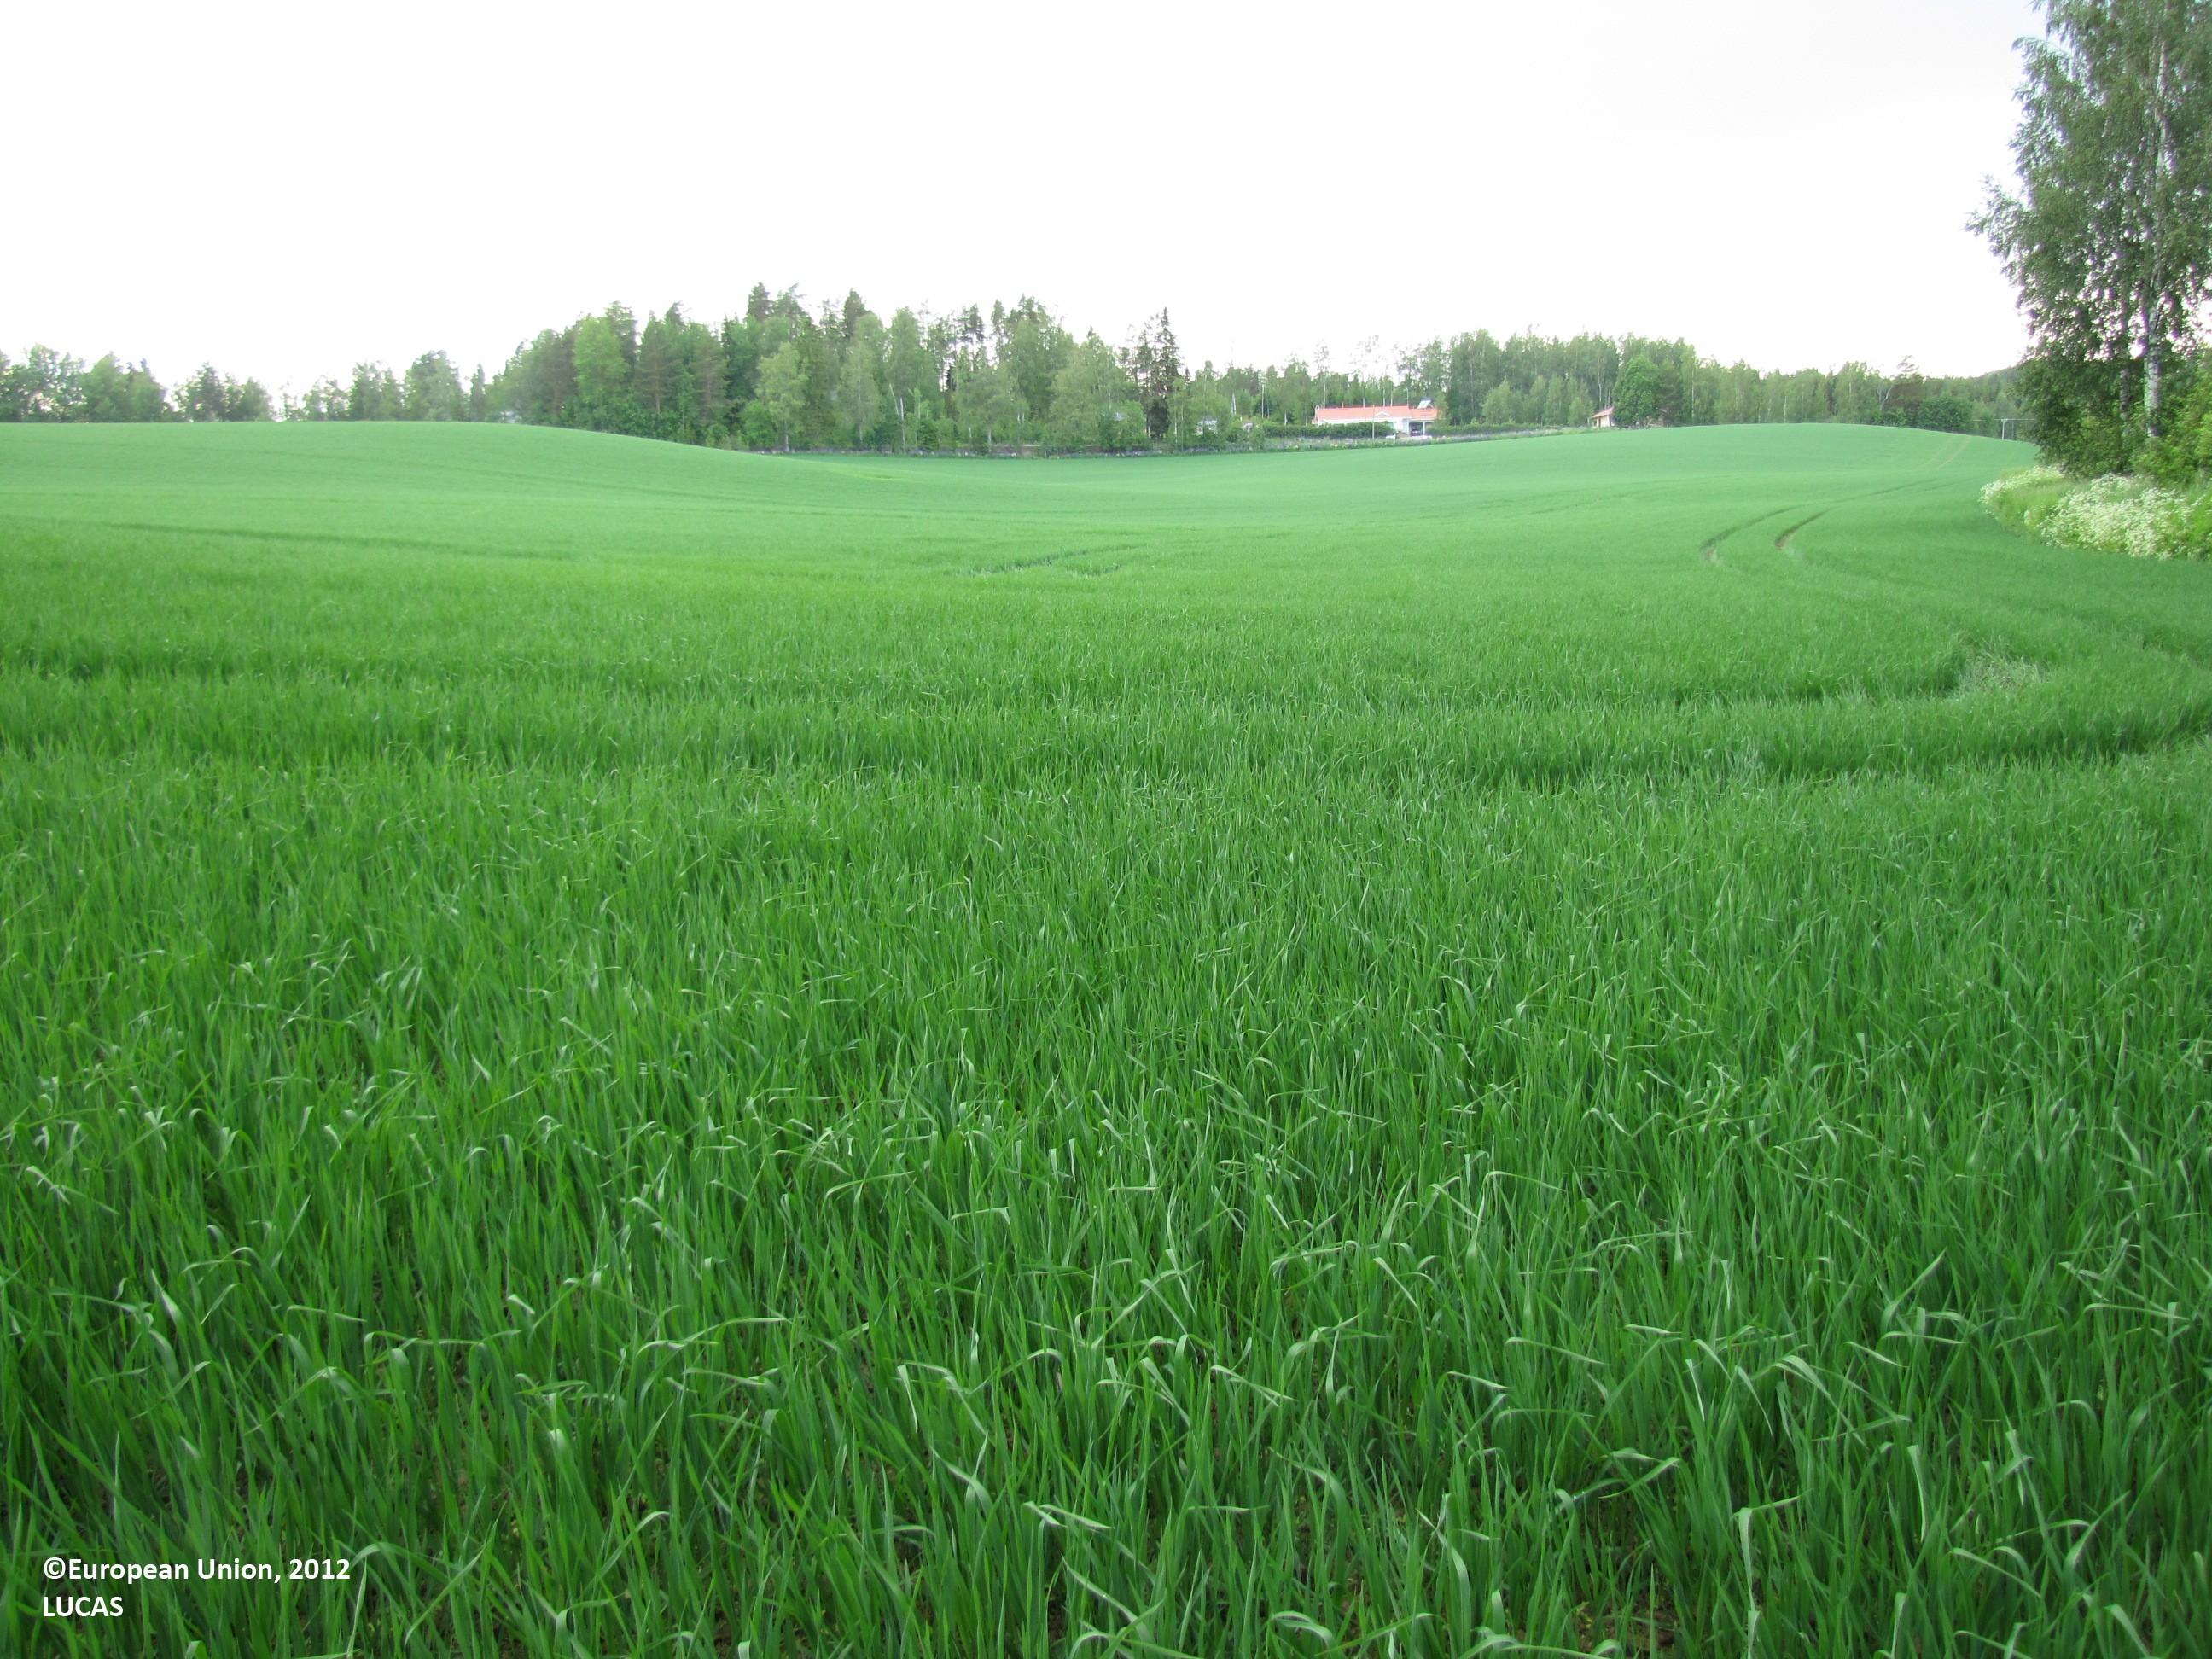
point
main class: Cropland
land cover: Oats
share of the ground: 50 - 75 %
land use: Agriculture (excluding fallow land and kitchen gardens)
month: June
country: FI
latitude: 61.6939
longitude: 24.4056
